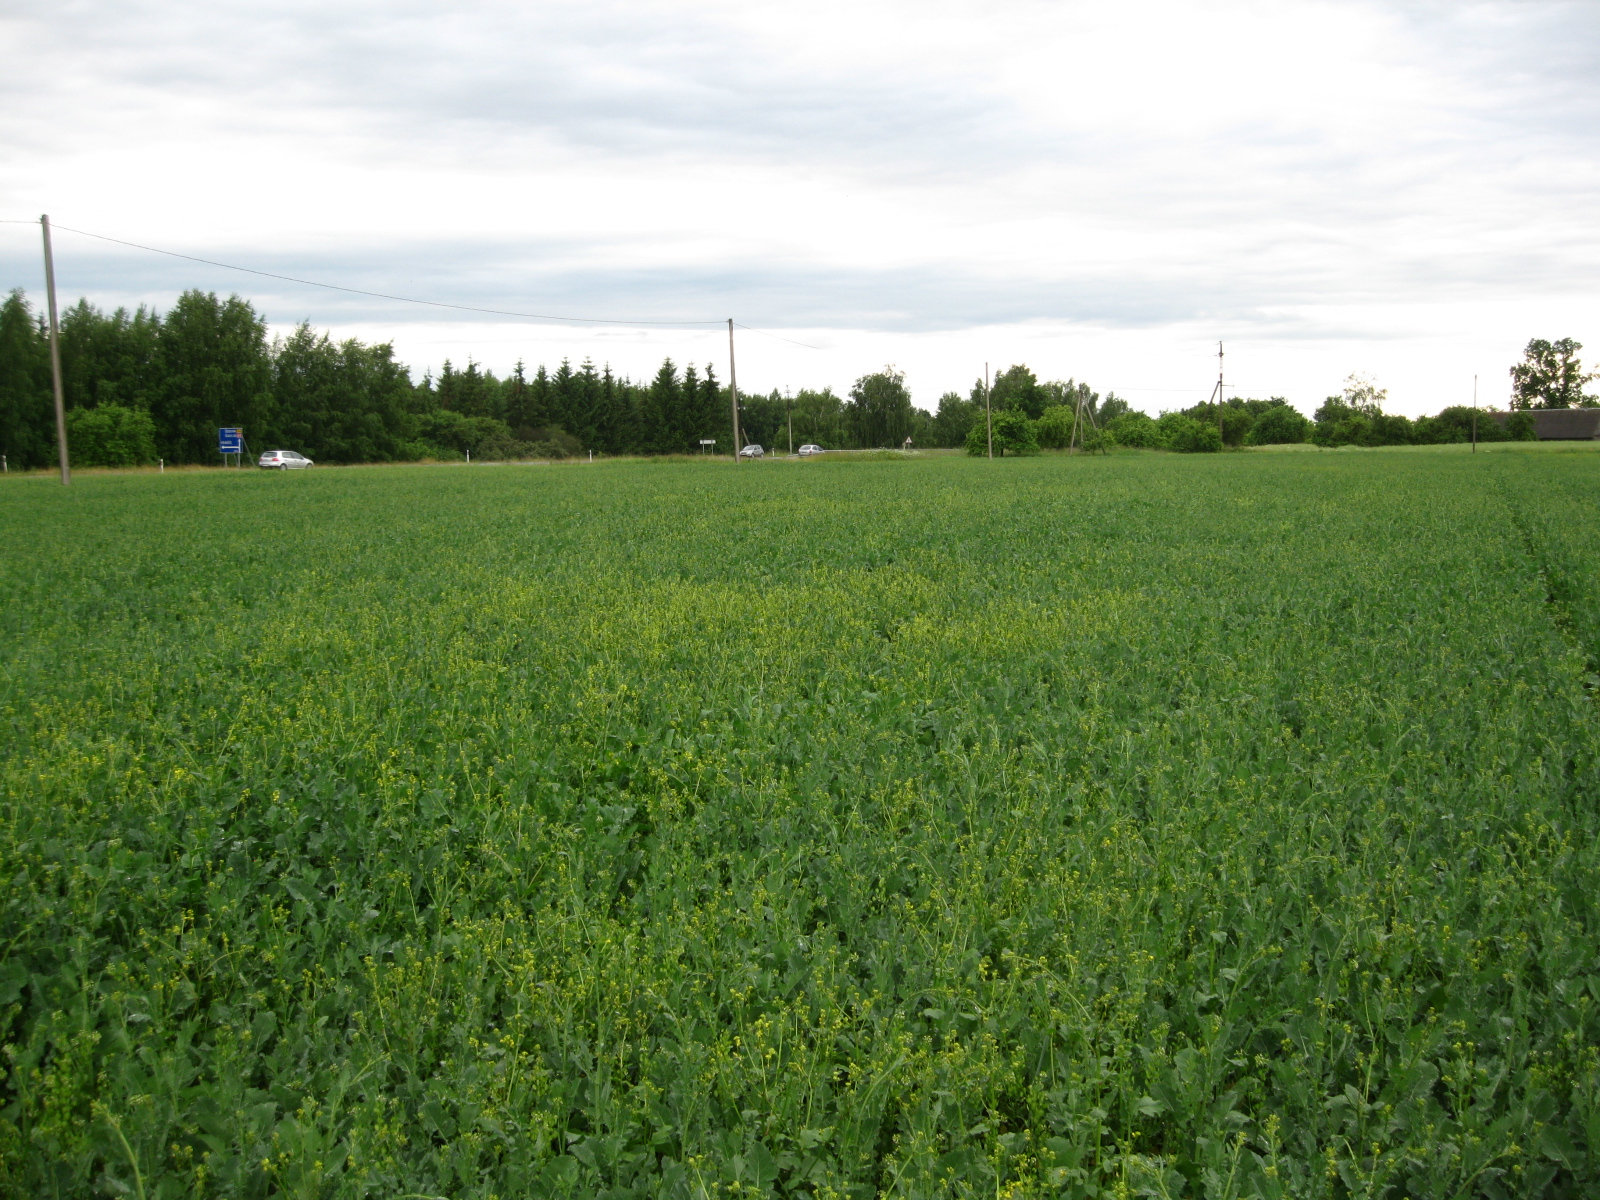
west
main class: Cropland
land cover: Rape and turnip rape
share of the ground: > 75 %
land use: Agriculture (excluding fallow land and kitchen gardens)
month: June
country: LT
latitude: 55.4140
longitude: 23.8448
